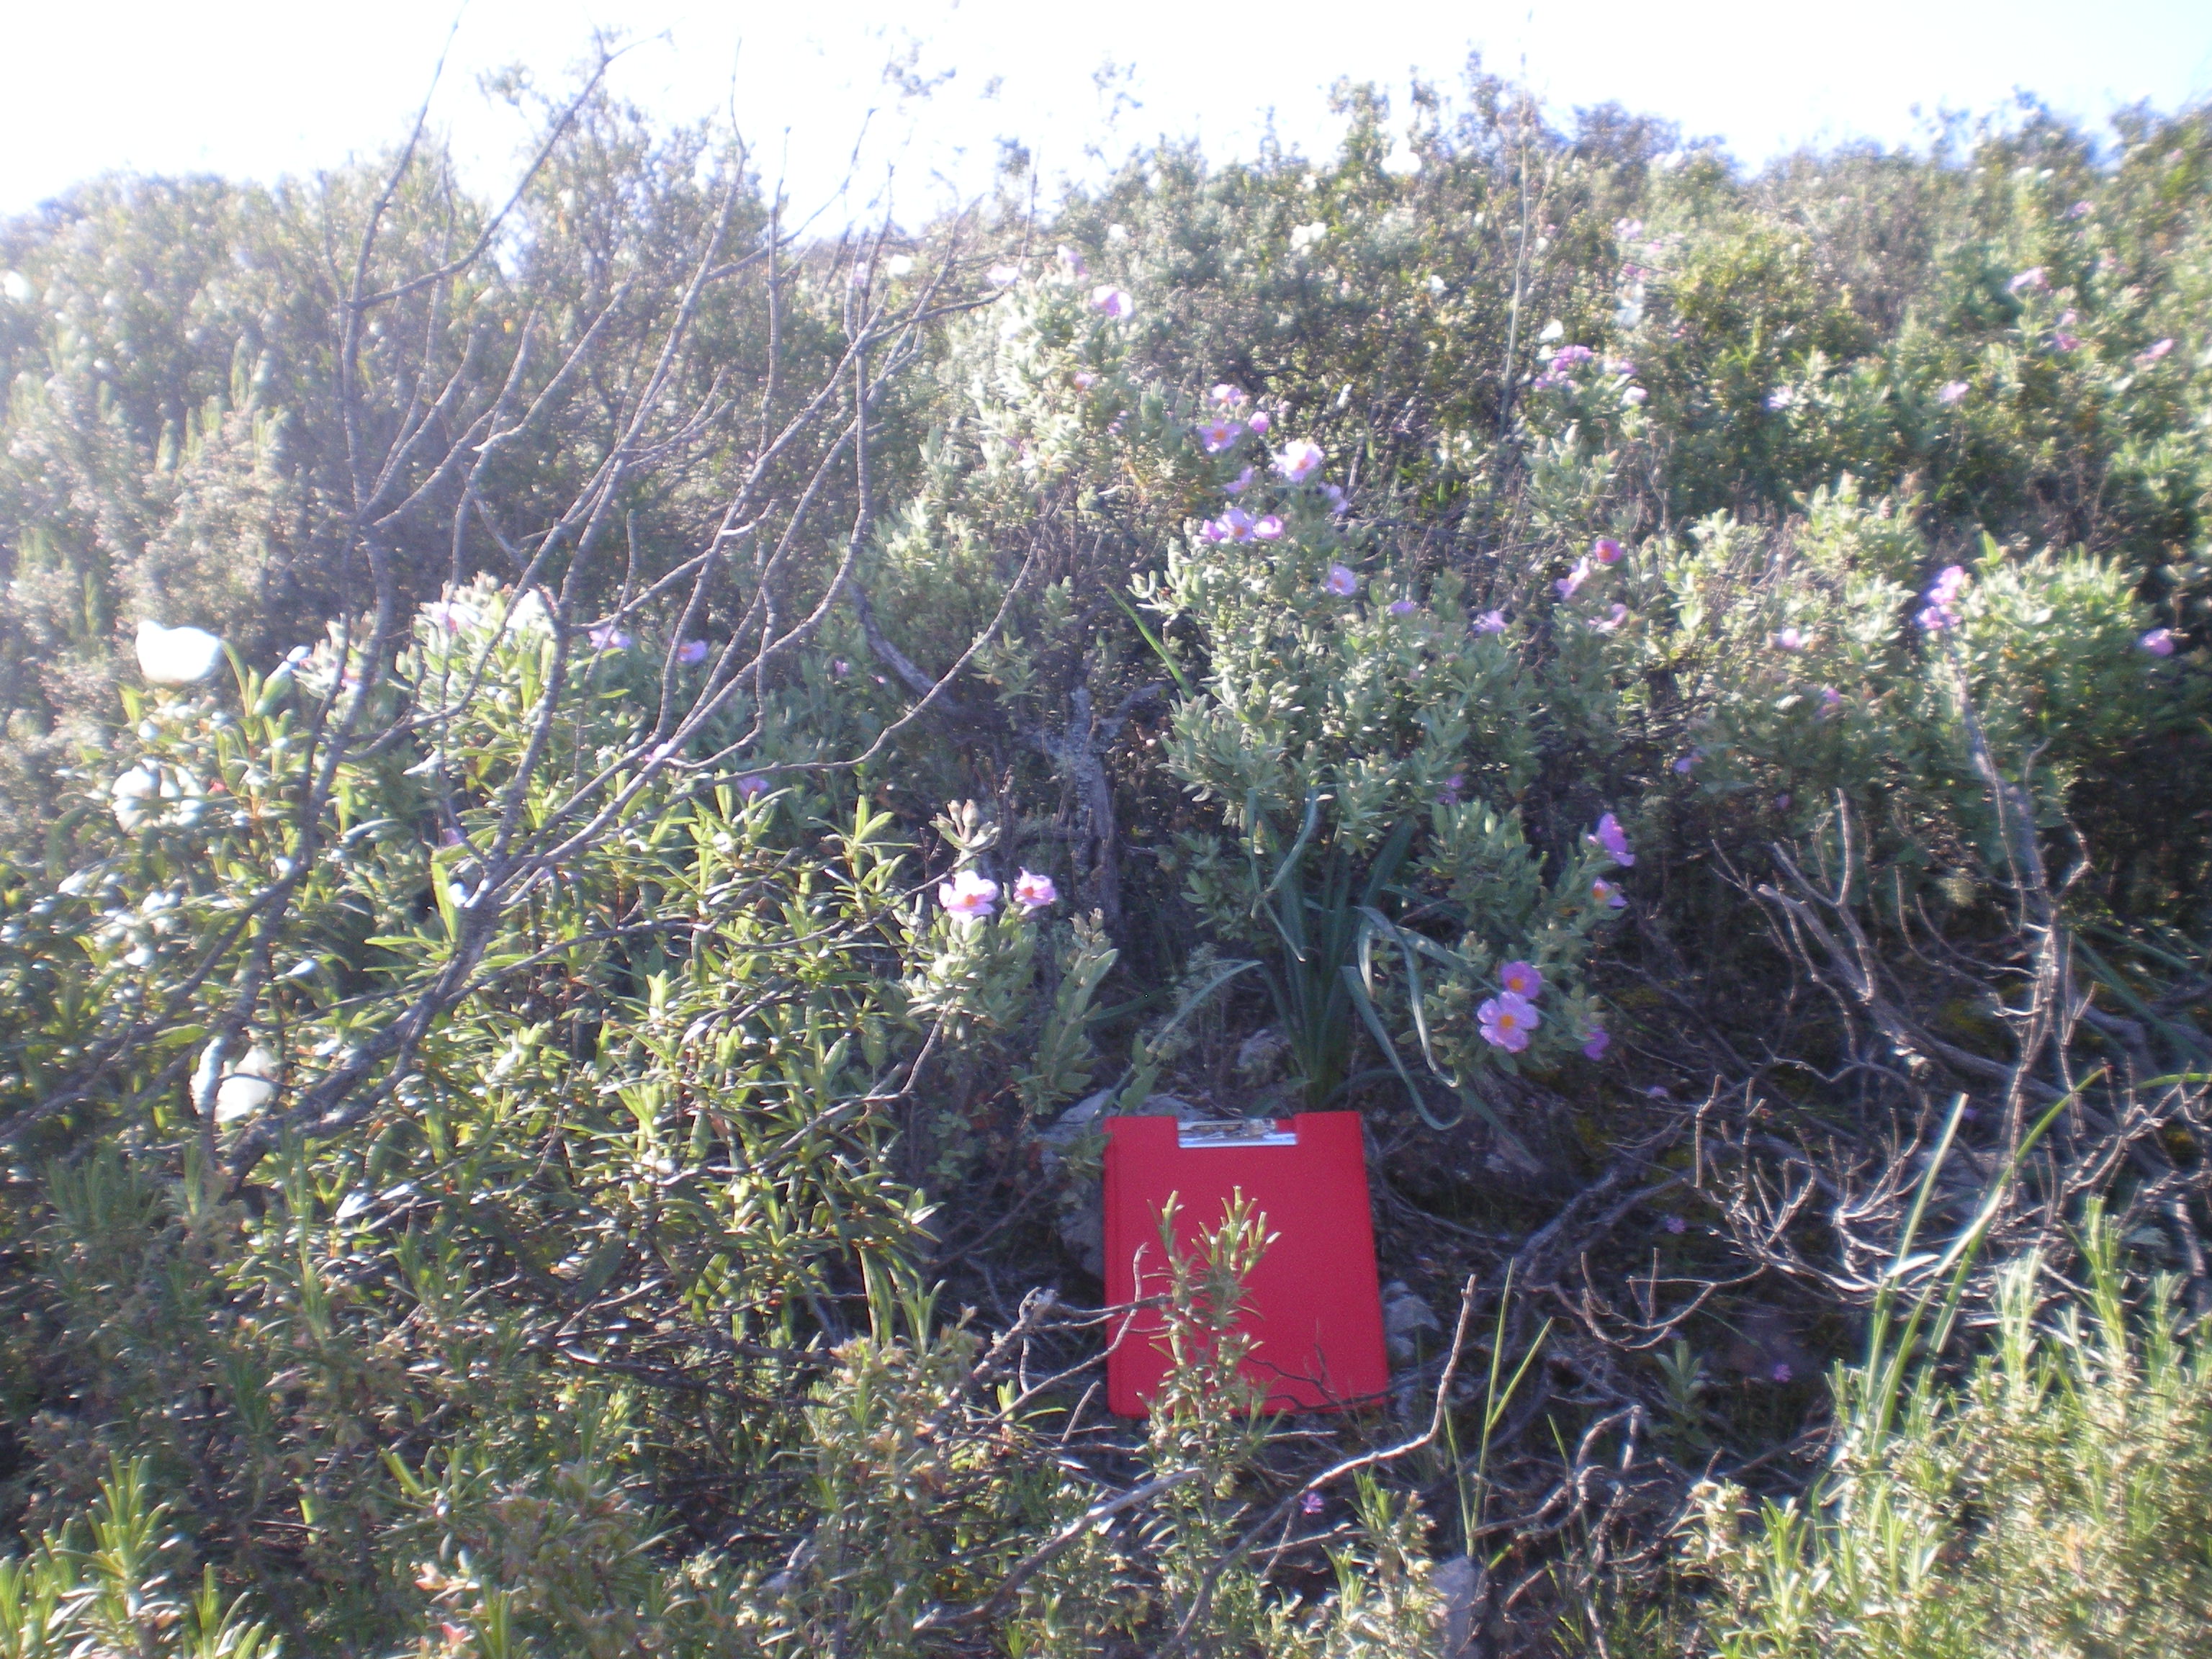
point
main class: Shrubland
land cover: Shrubland with sparse tree cover
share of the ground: > 75 %
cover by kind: shrubs 80 %, consolidated bare surface 15 %, broadleaved forest trees 5 %
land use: Other primary production
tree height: < 5 m
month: April
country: ES
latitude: 38.5651
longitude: -3.3321
